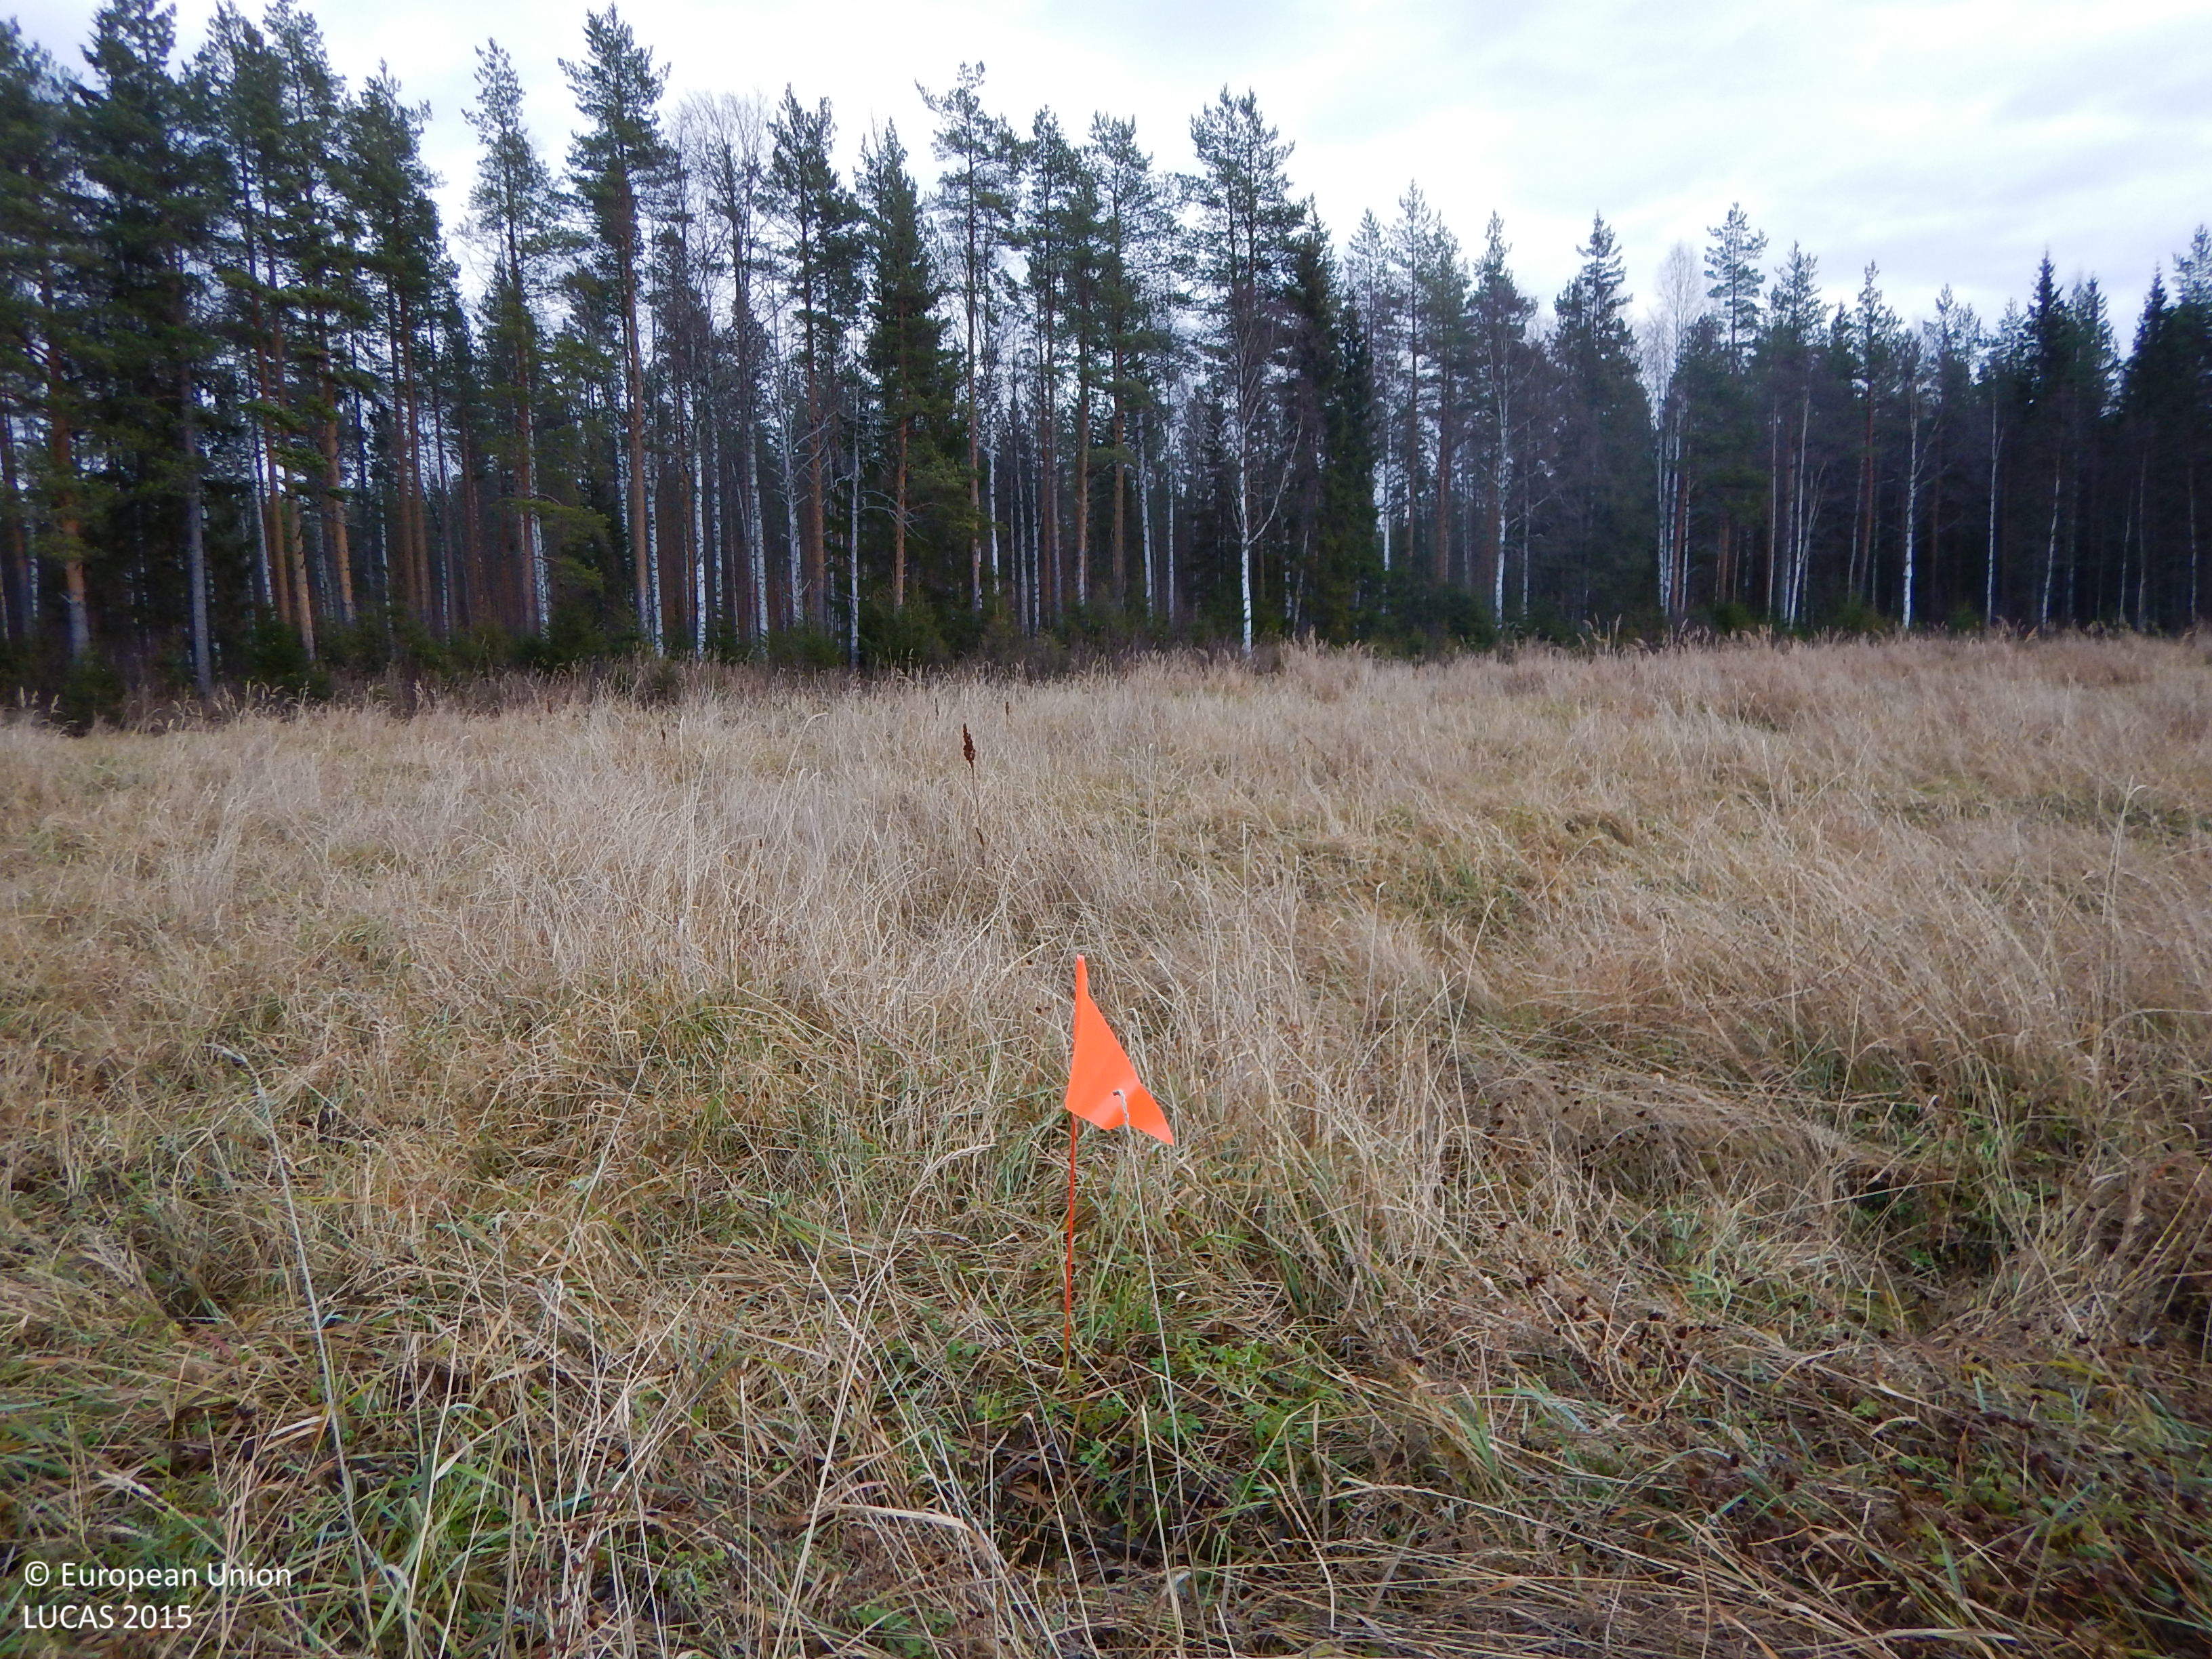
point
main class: Grassland
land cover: Grassland without tree/shrub cover
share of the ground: > 75 %
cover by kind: herbaceous plants 95 %, shrubs 5 %
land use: Agriculture (excluding fallow land and kitchen gardens)
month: November
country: SE
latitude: 65.3971
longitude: 21.1015
